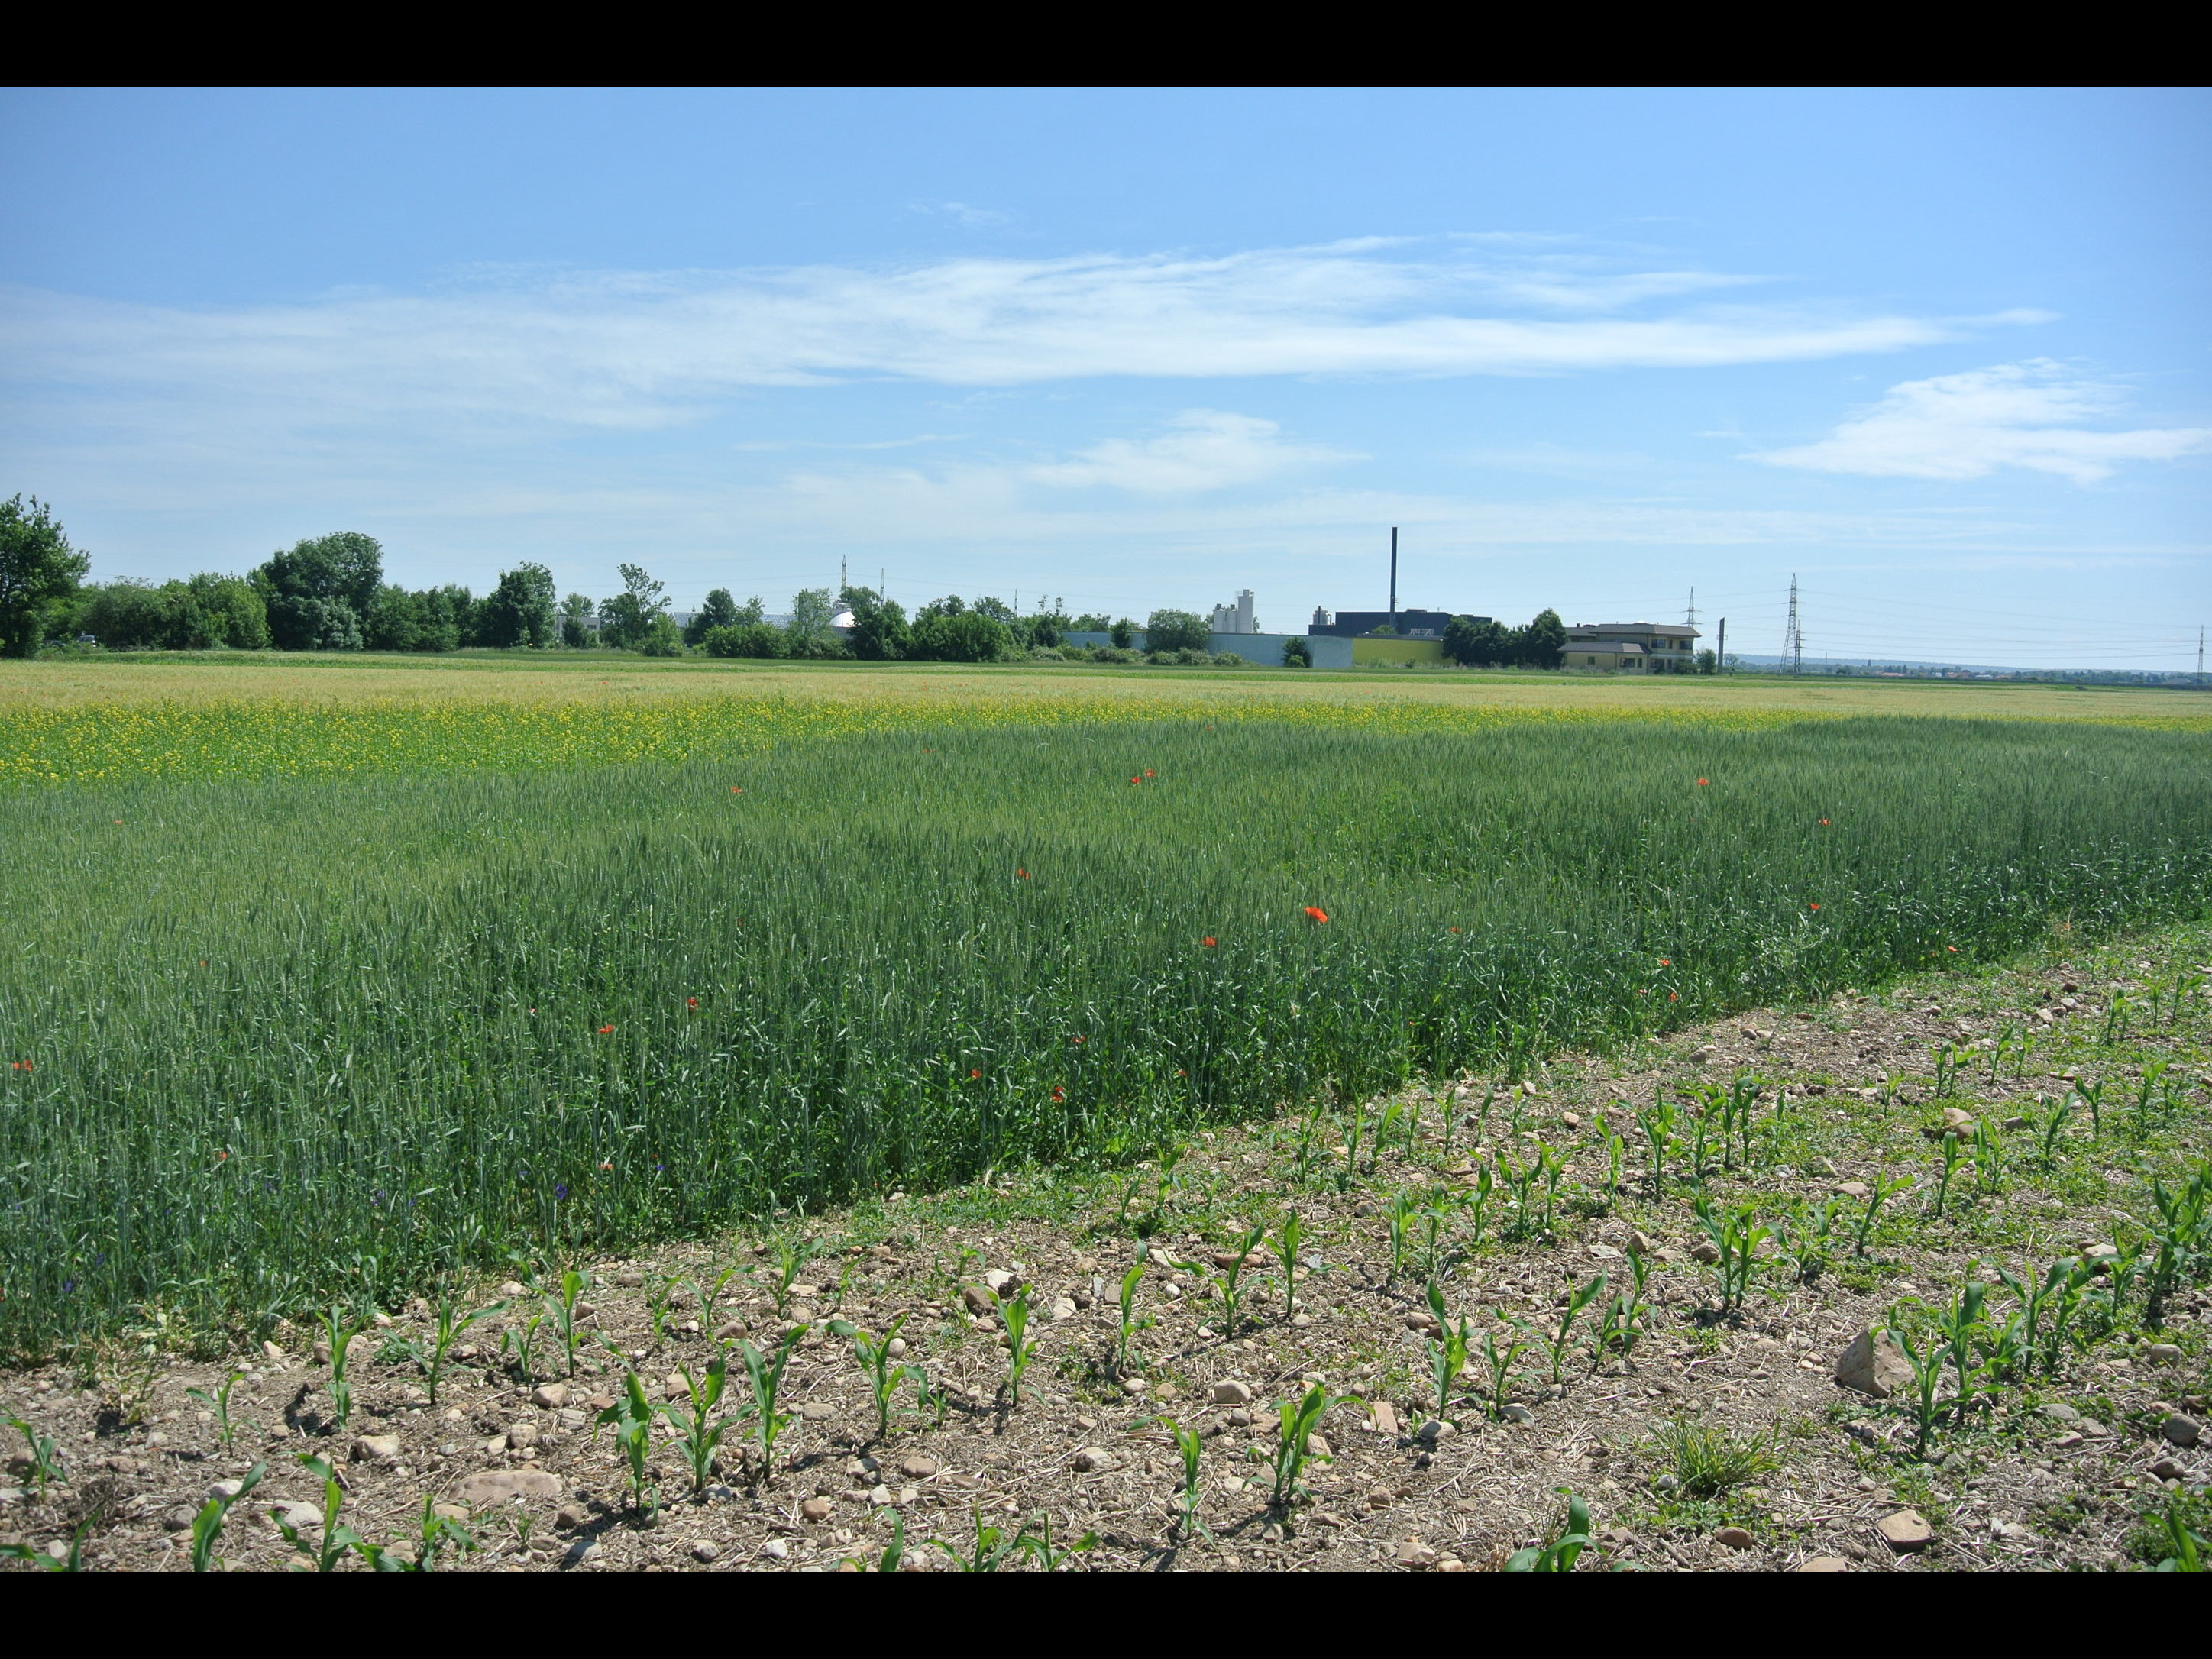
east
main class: Cropland
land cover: Maize
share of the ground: 10 - 25 %
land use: Agriculture (excluding fallow land and kitchen gardens)
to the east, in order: Maize; Common wheat; Rape and turnip rape; Barley; Maize; Barley; Common wheat; Barley; Shrubland with sparse tree cover; Grassland without tree/shrub cover; Single bushes/trees; Inland fresh running water
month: June
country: AT
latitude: 47.8309
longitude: 16.5374
